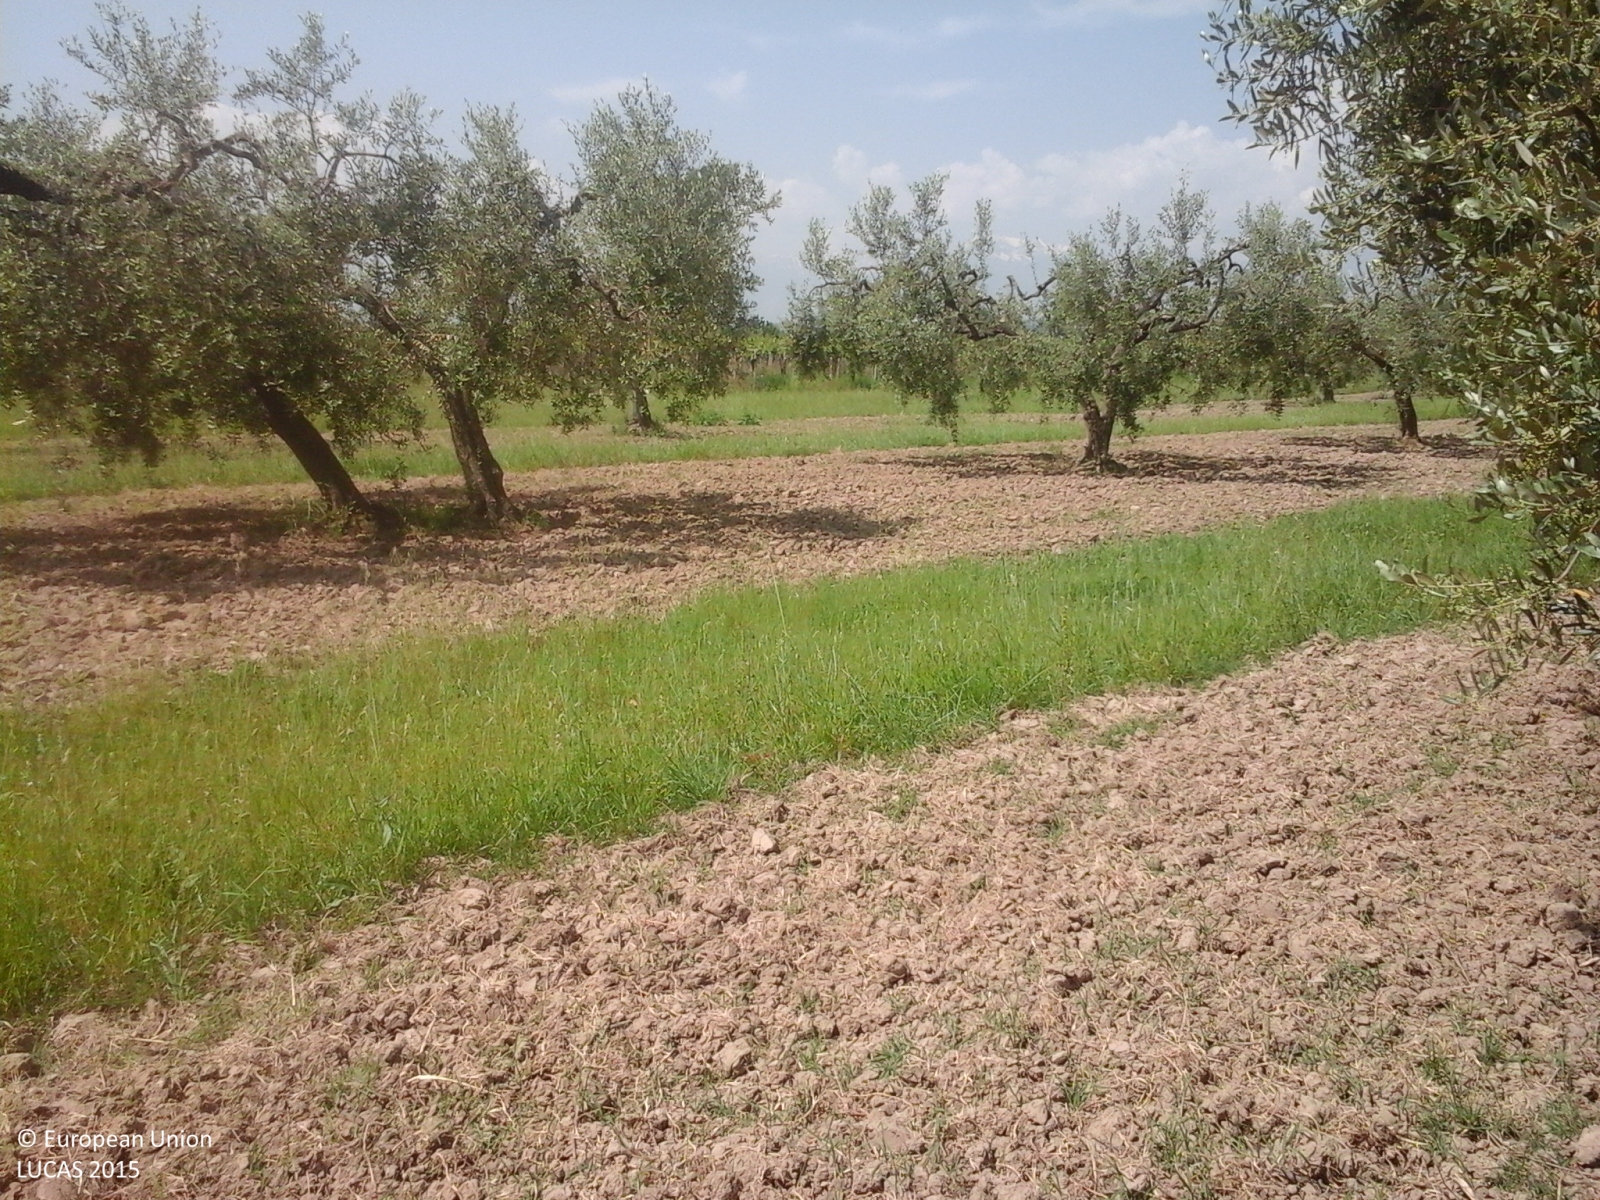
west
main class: Cropland
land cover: Olive groves
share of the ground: 25 - 50 %
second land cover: Other bare soil
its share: > 75 %
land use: Agriculture (excluding fallow land and kitchen gardens)
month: May
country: IT
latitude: 42.2101
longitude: 14.5044
